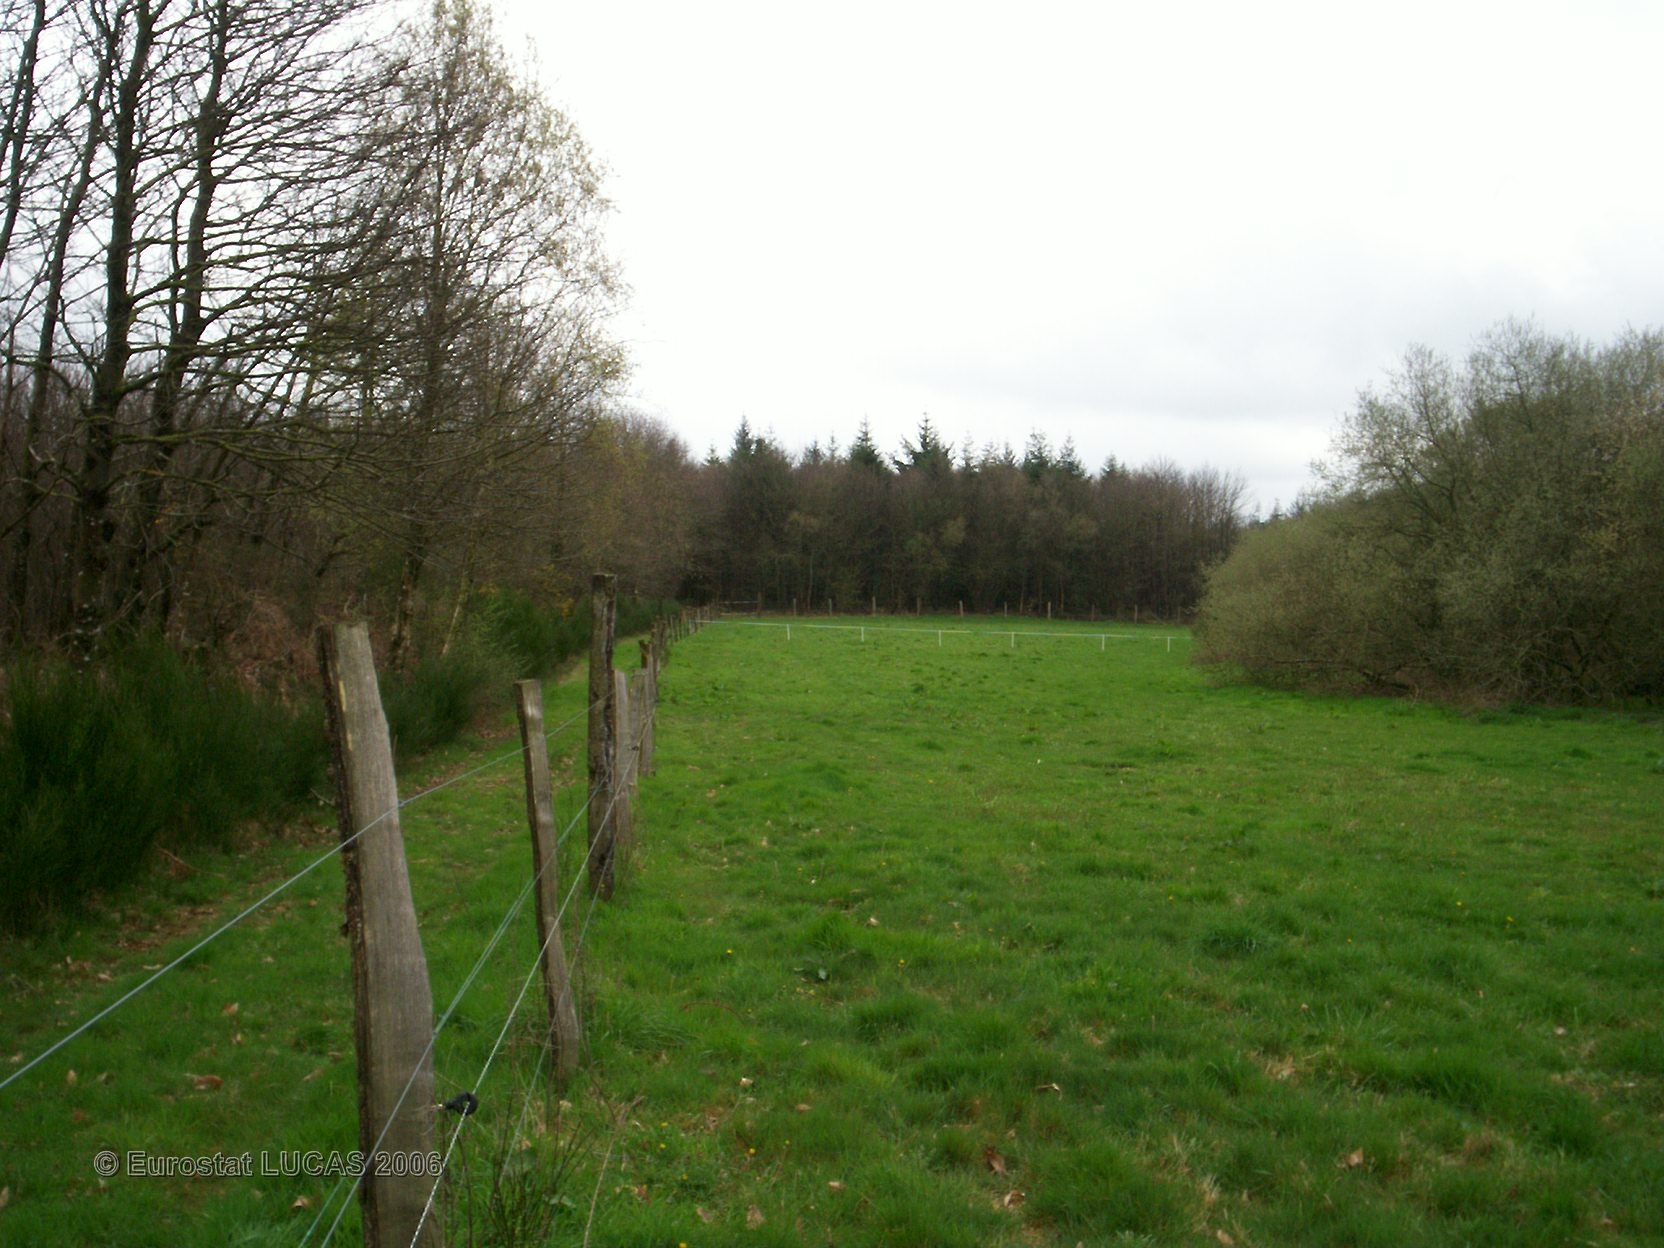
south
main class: Grassland
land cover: Grassland without tree/shrub cover
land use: Agriculture (excluding fallow land and kitchen gardens)
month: April
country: FR
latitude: 47.8114
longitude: -2.8712
